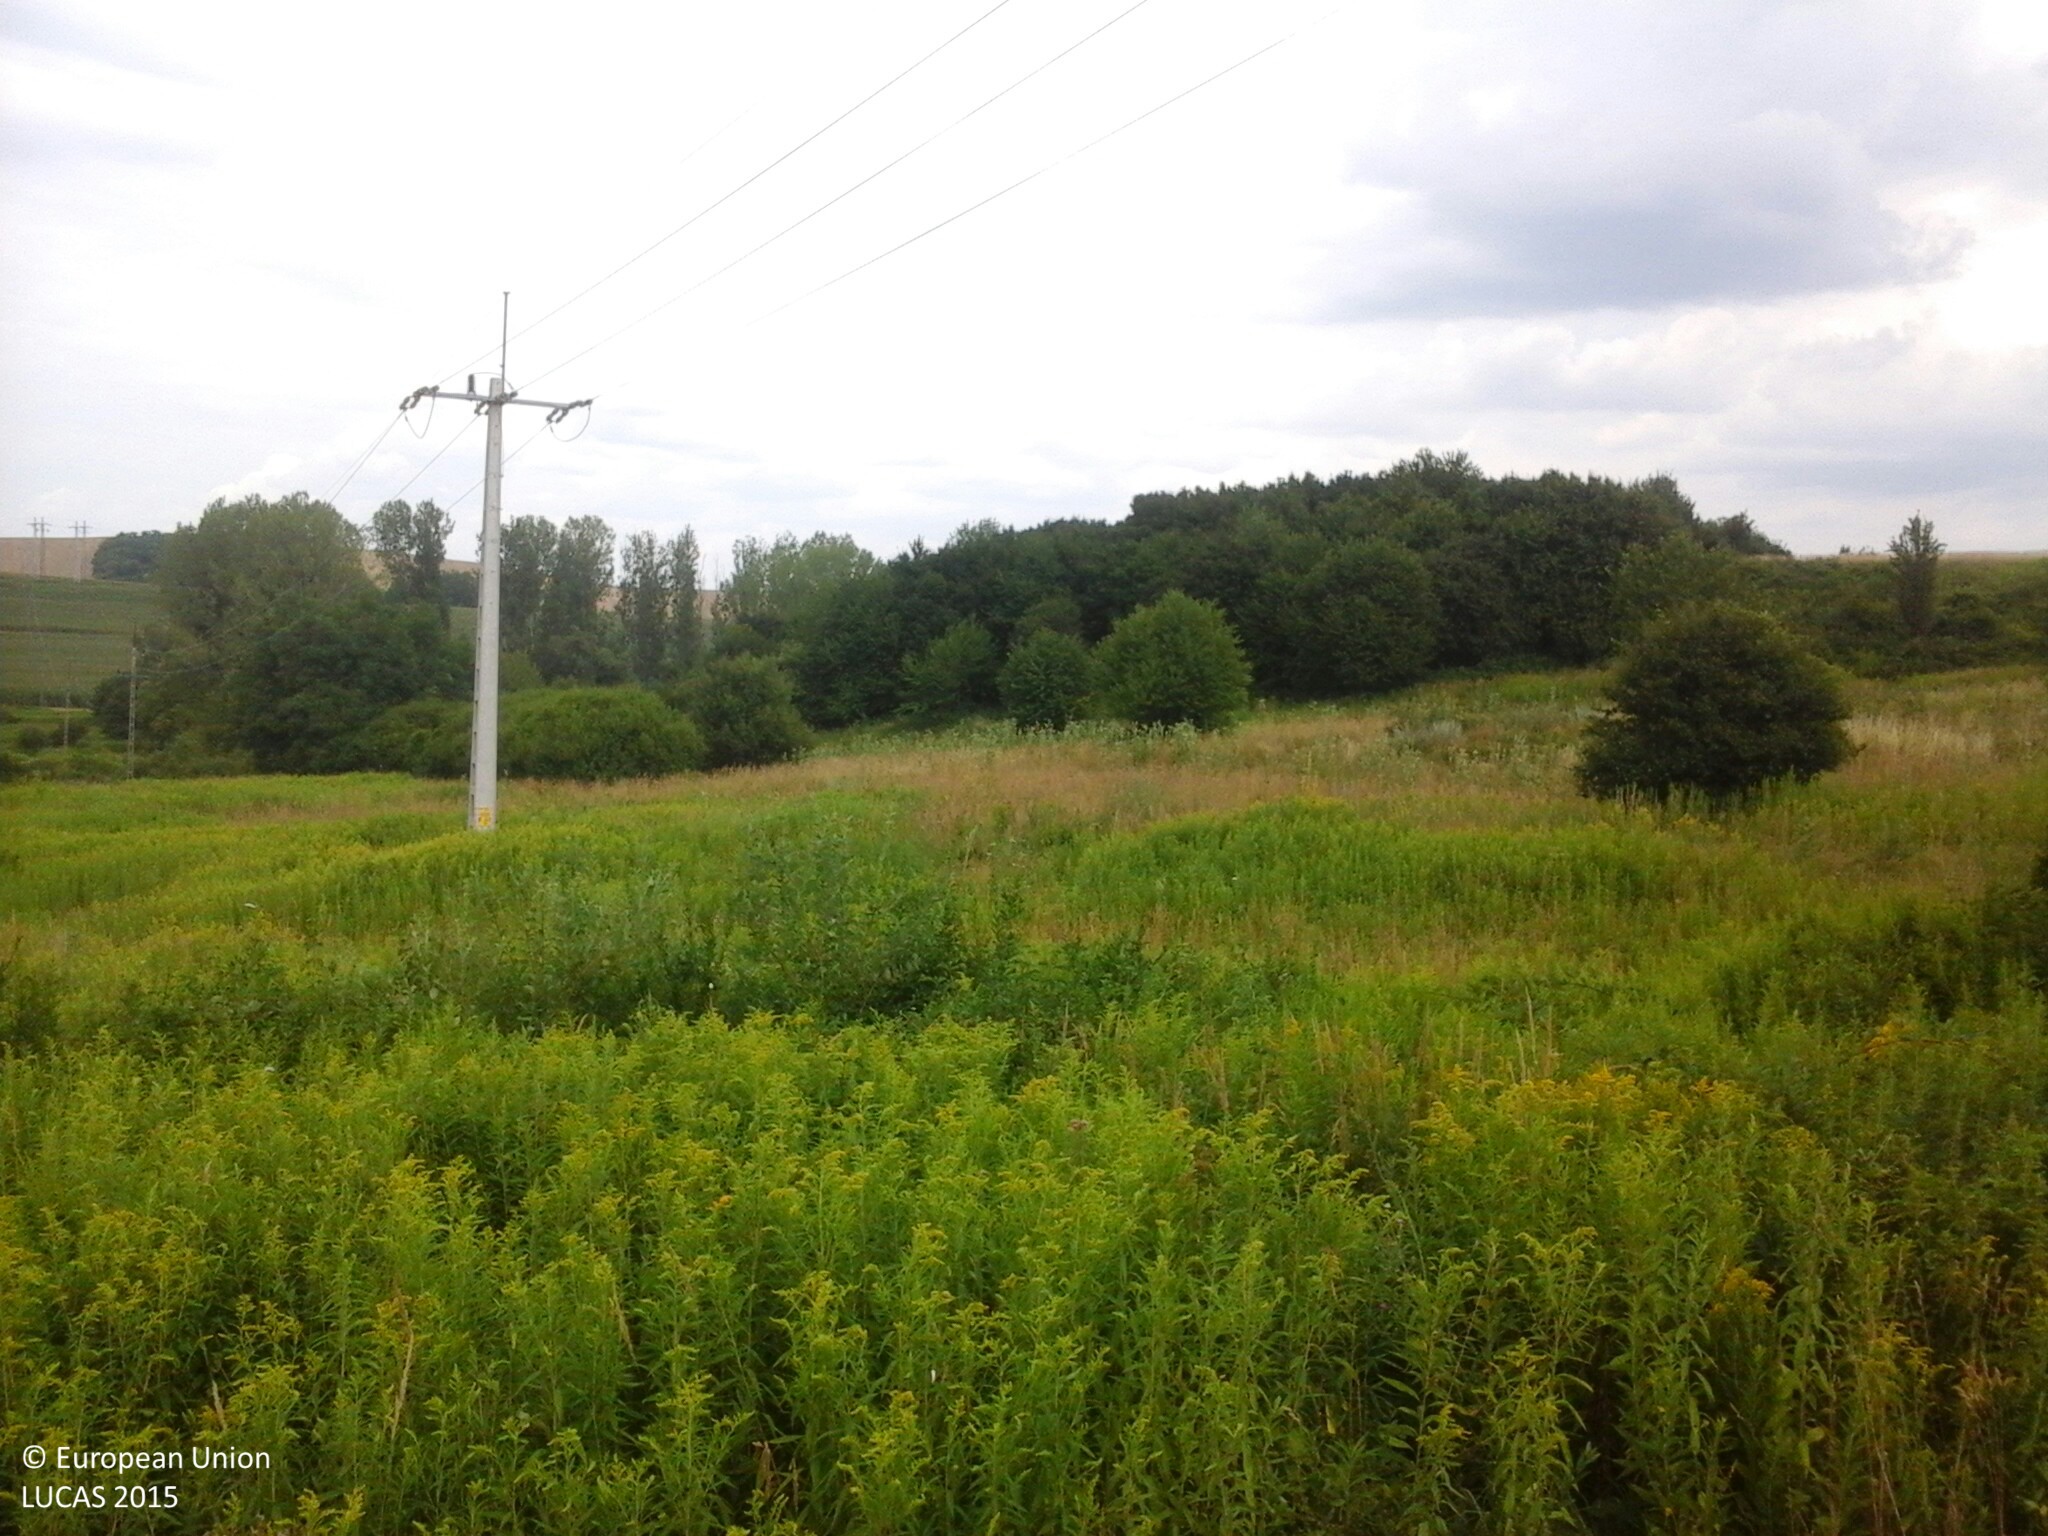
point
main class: Grassland
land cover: Spontaneously vegetated surfaces
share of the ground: > 75 %
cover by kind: herbaceous plants 100 %
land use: Semi-natural and natural areas not in use
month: July
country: HU
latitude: 47.3007
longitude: 17.9849
